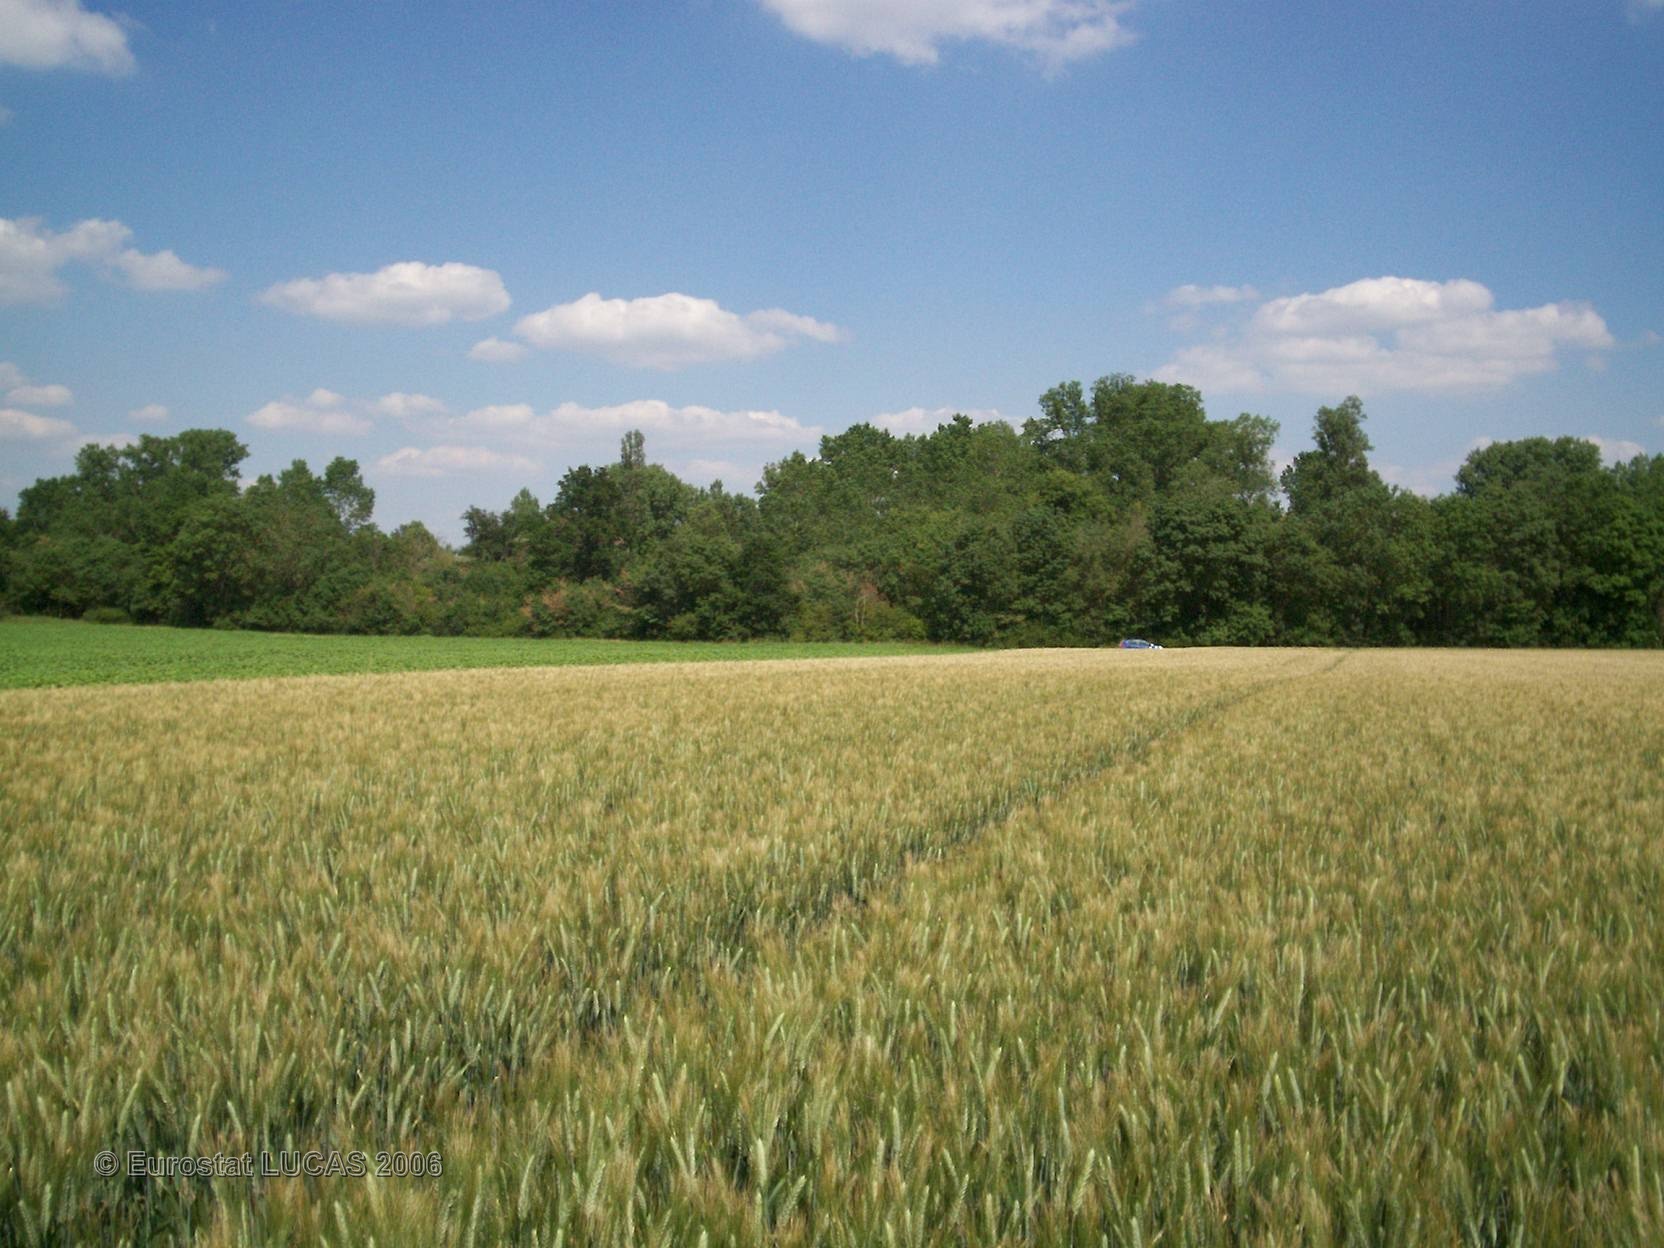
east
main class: Cropland
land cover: Durum wheat
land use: Agriculture (excluding fallow land and kitchen gardens)
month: June
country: FR
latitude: 46.2586
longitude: -0.7829
